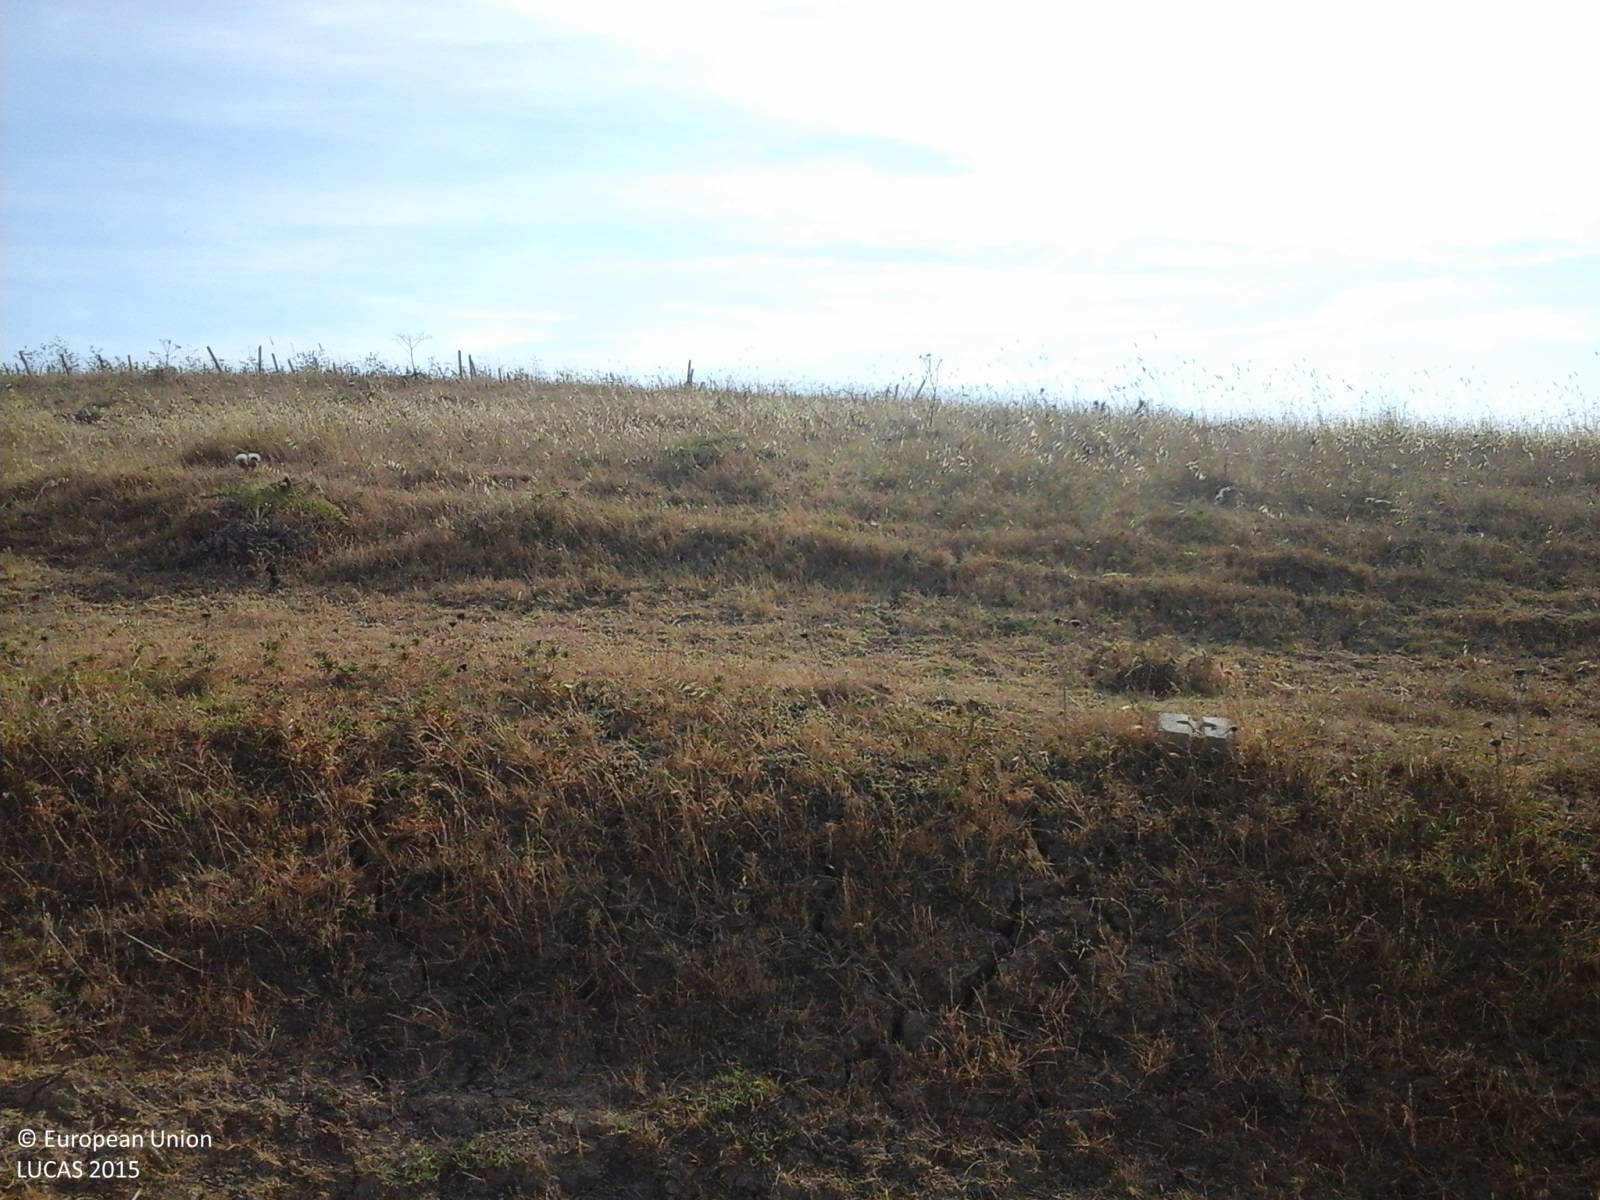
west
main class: Grassland
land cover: Grassland without tree/shrub cover
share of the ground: > 75 %
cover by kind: herbaceous plants 100 %
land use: Agriculture (excluding fallow land and kitchen gardens)
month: June
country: IT
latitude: 37.8033
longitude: 12.5816
